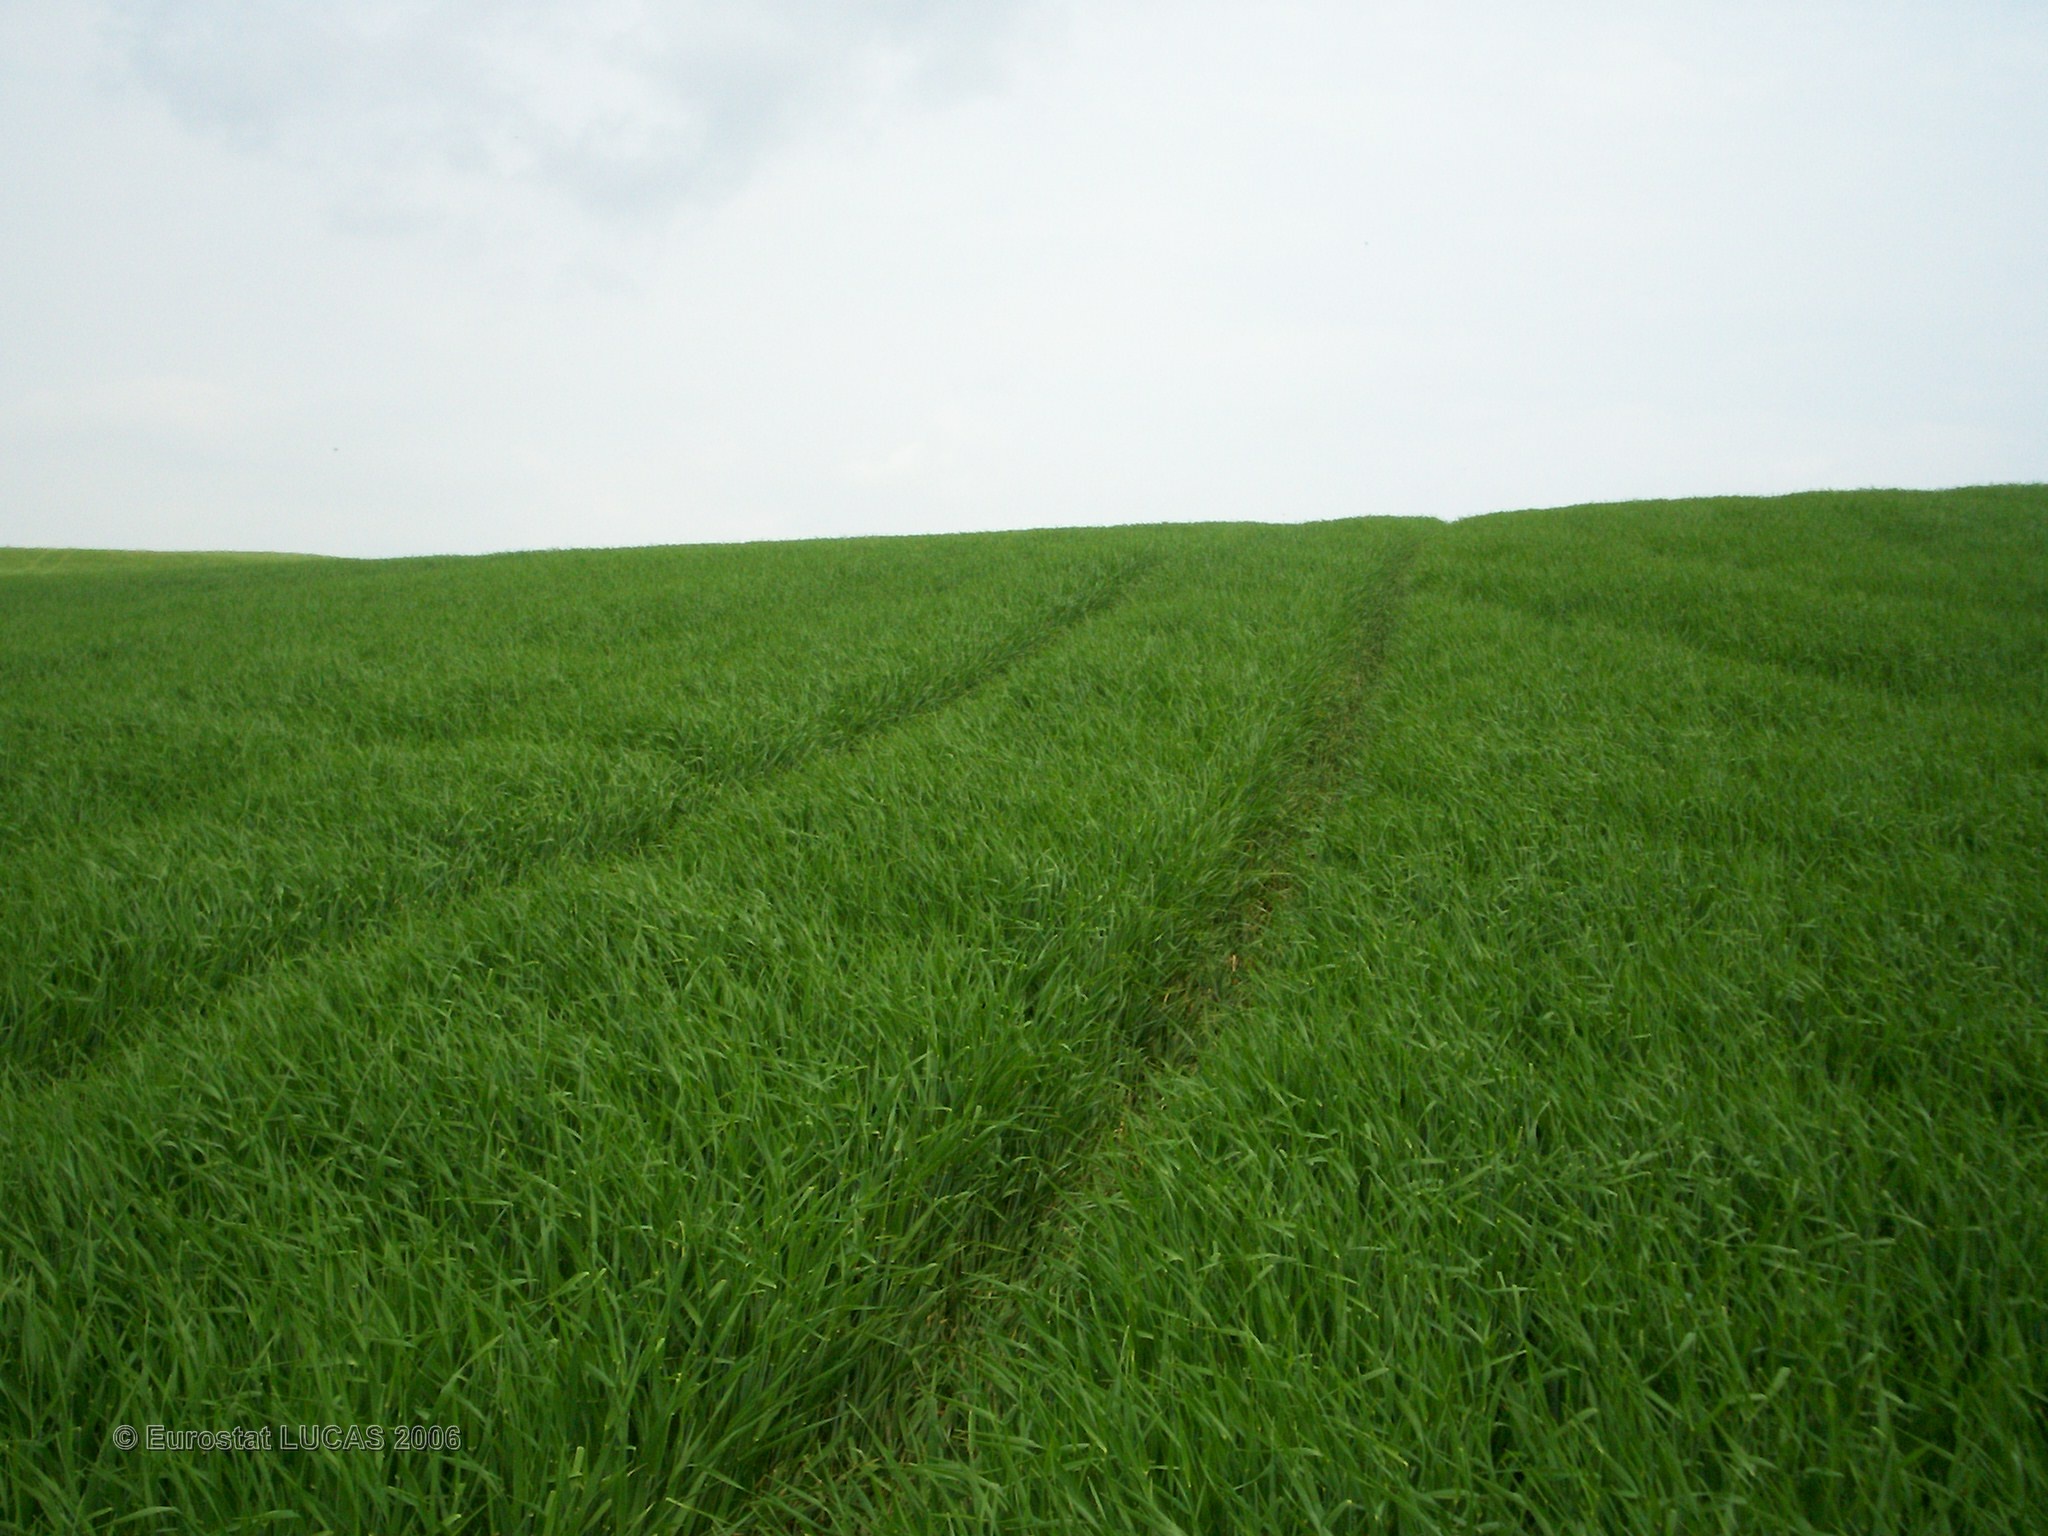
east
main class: Cropland
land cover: Barley
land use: Agriculture (excluding fallow land and kitchen gardens)
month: May
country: FR
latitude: 47.4401
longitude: 3.8847
